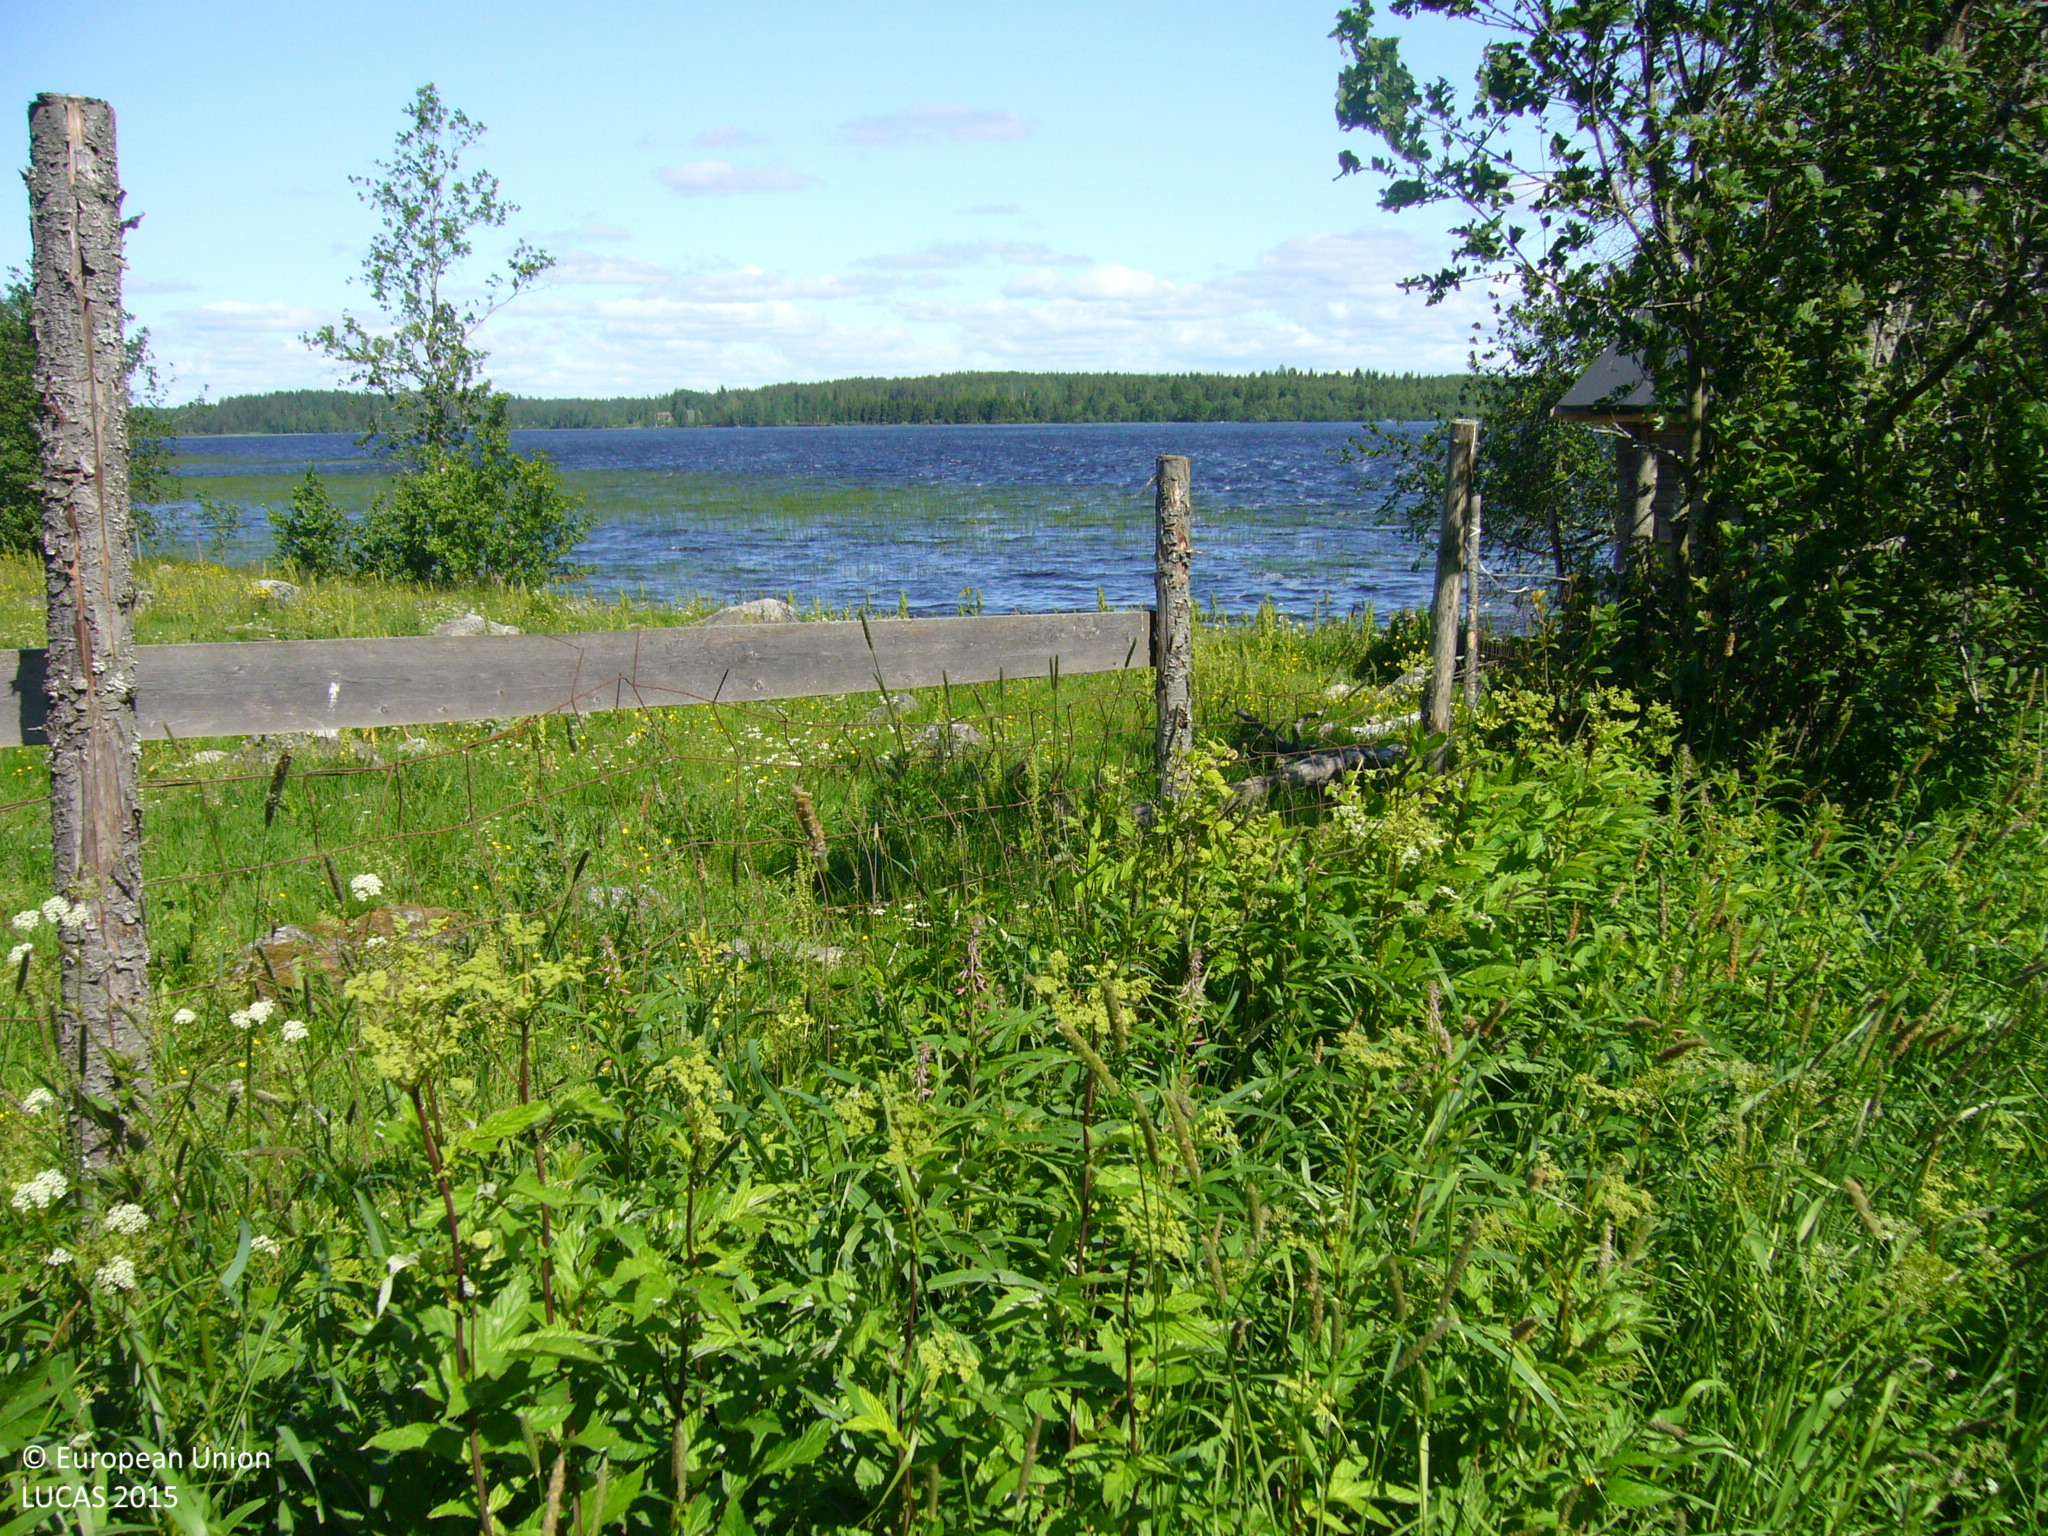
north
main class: Grassland
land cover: Grassland without tree/shrub cover
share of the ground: > 75 %
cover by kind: herbaceous plants 100 %
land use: Agriculture (excluding fallow land and kitchen gardens)
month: July
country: FI
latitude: 63.3310
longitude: 26.2373
